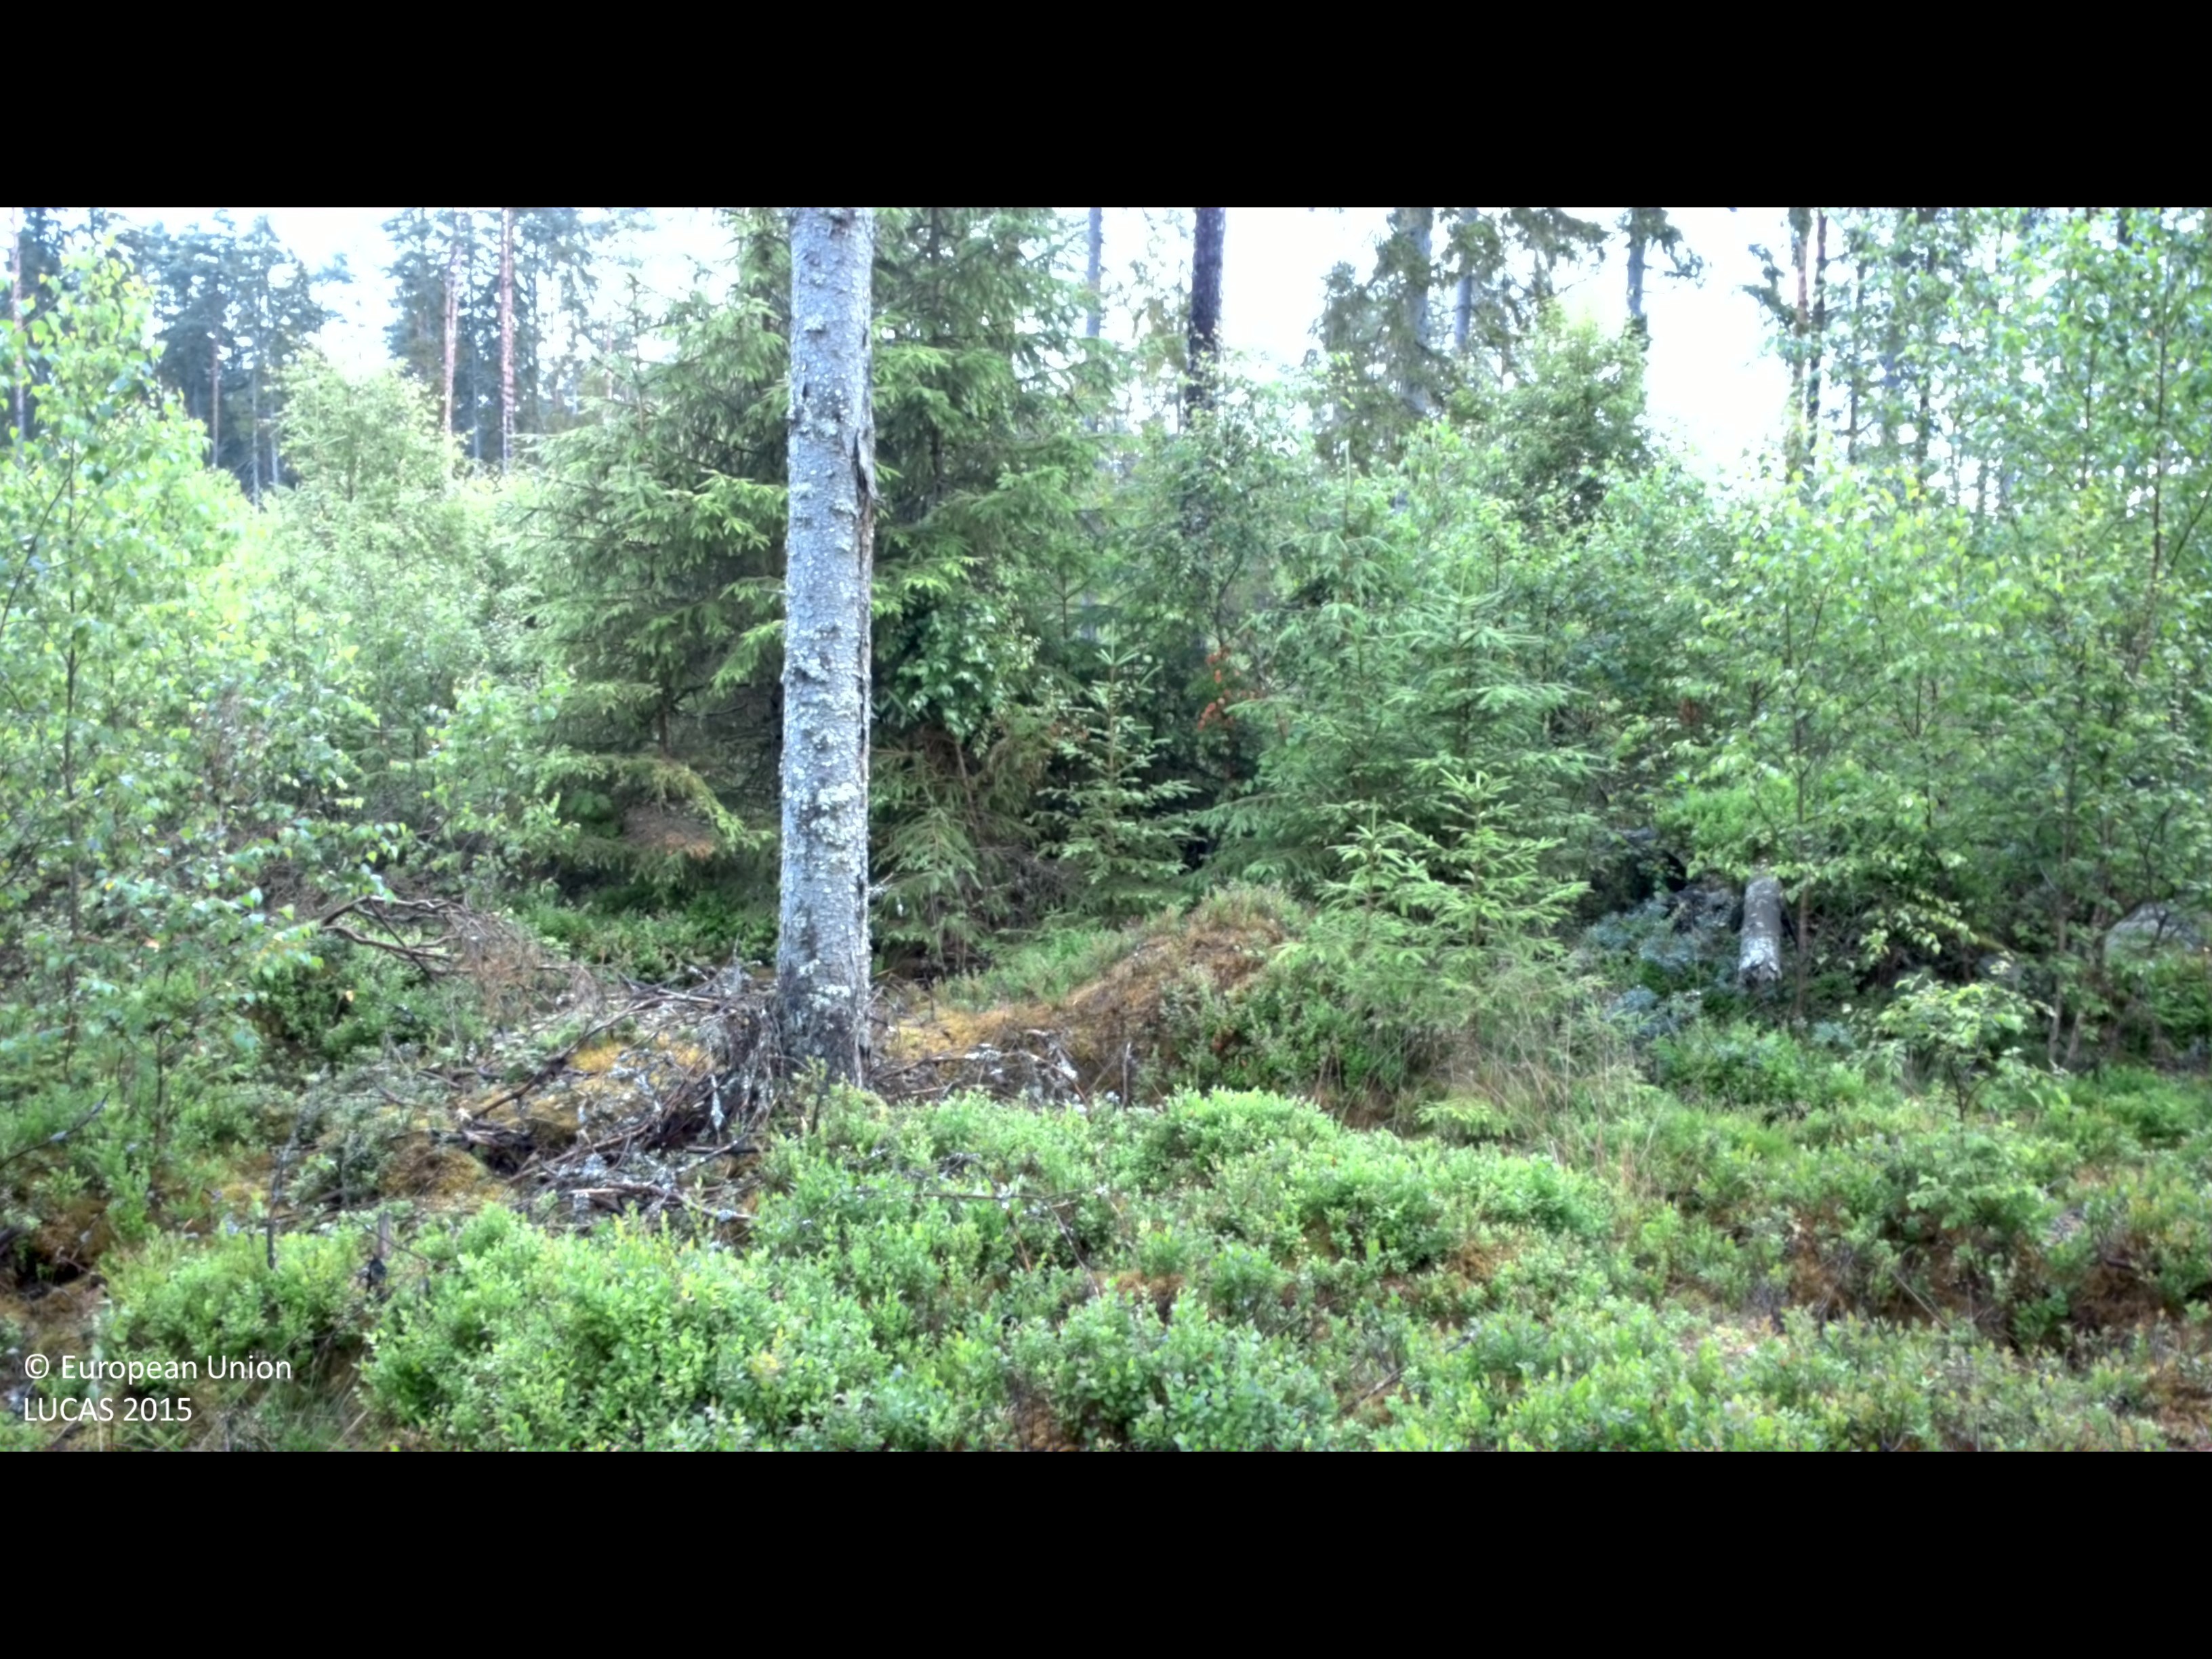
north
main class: Woodland
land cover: Pine dominated mixed woodland
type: boreal forest
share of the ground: 50 - 75 %
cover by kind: coniferous forest trees 55 %, broadleaved forest trees 20 %, shrubs 20 %, lichens and mosses 5 %
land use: Forestry
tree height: > 5 m
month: July
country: SE
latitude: 56.6026
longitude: 14.2812
